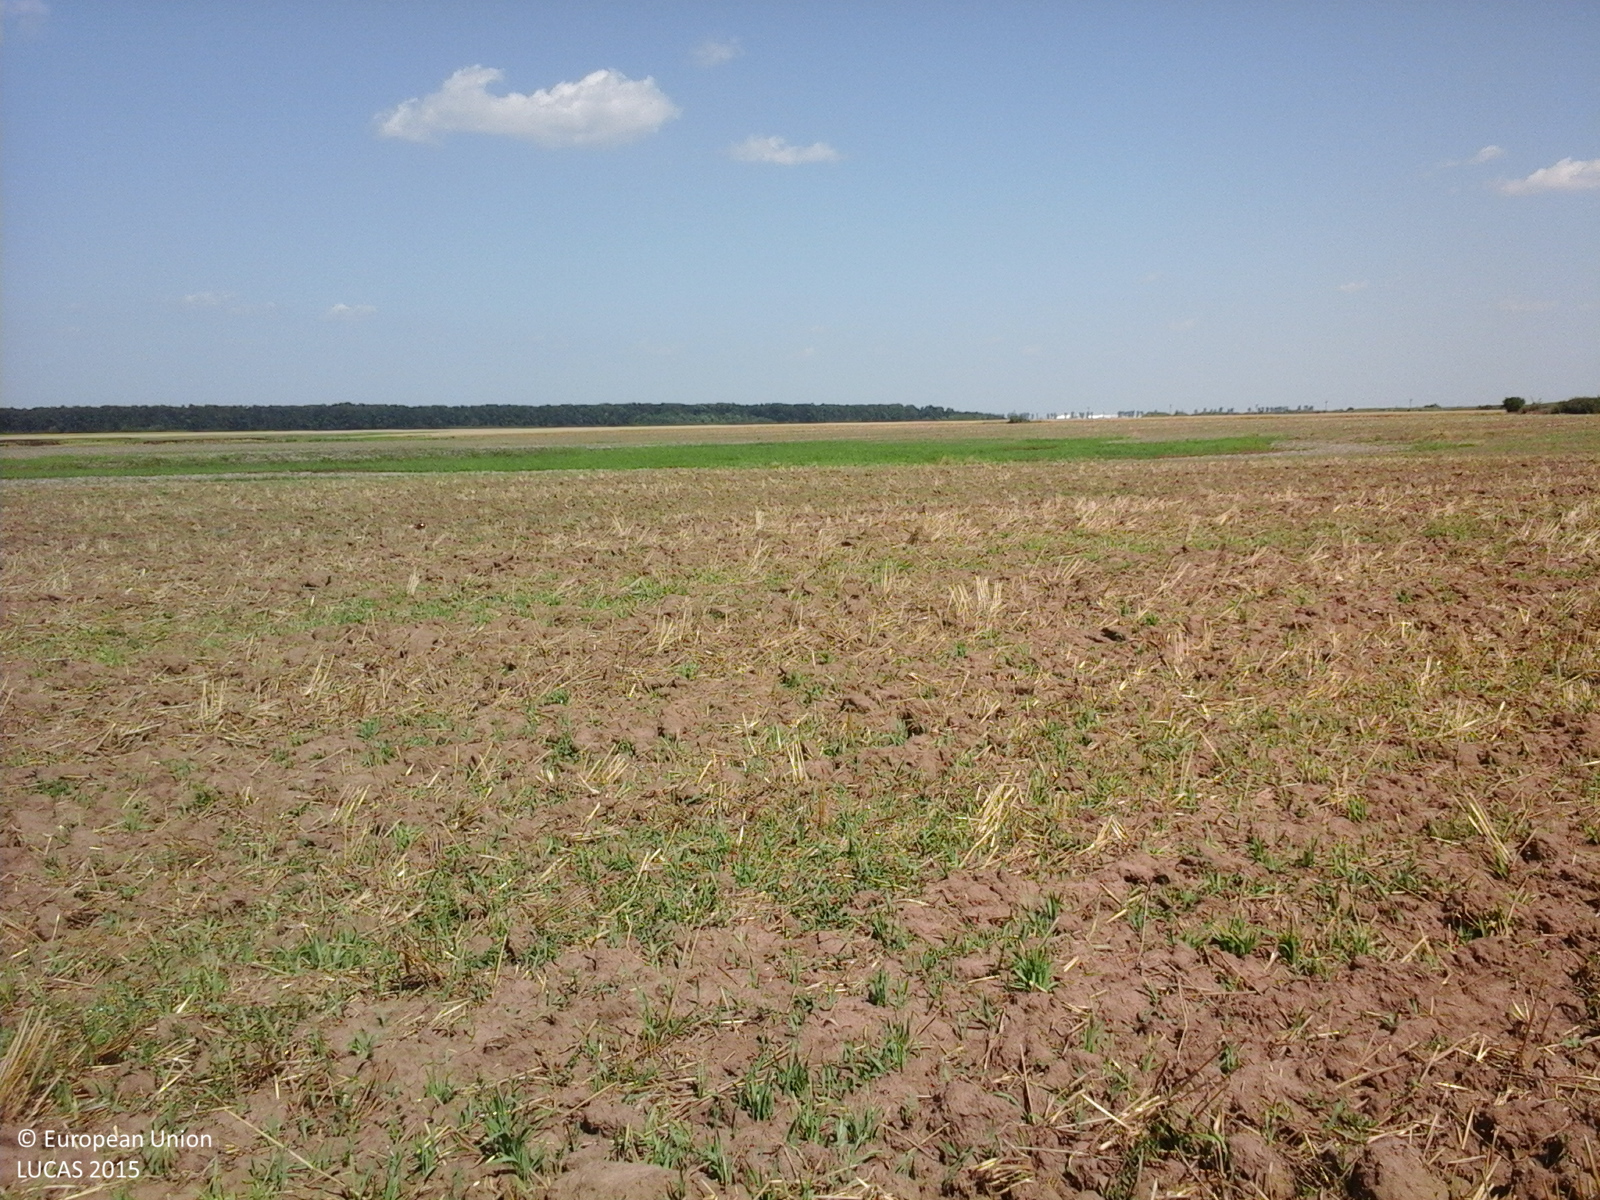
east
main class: Cropland
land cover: Durum wheat
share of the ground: < 10 %
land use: Agriculture (excluding fallow land and kitchen gardens)
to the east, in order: Durum wheat; Other bare soil; Grassland without tree/shrub cover; Common wheat
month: July
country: RO
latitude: 44.1977
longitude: 24.5462
